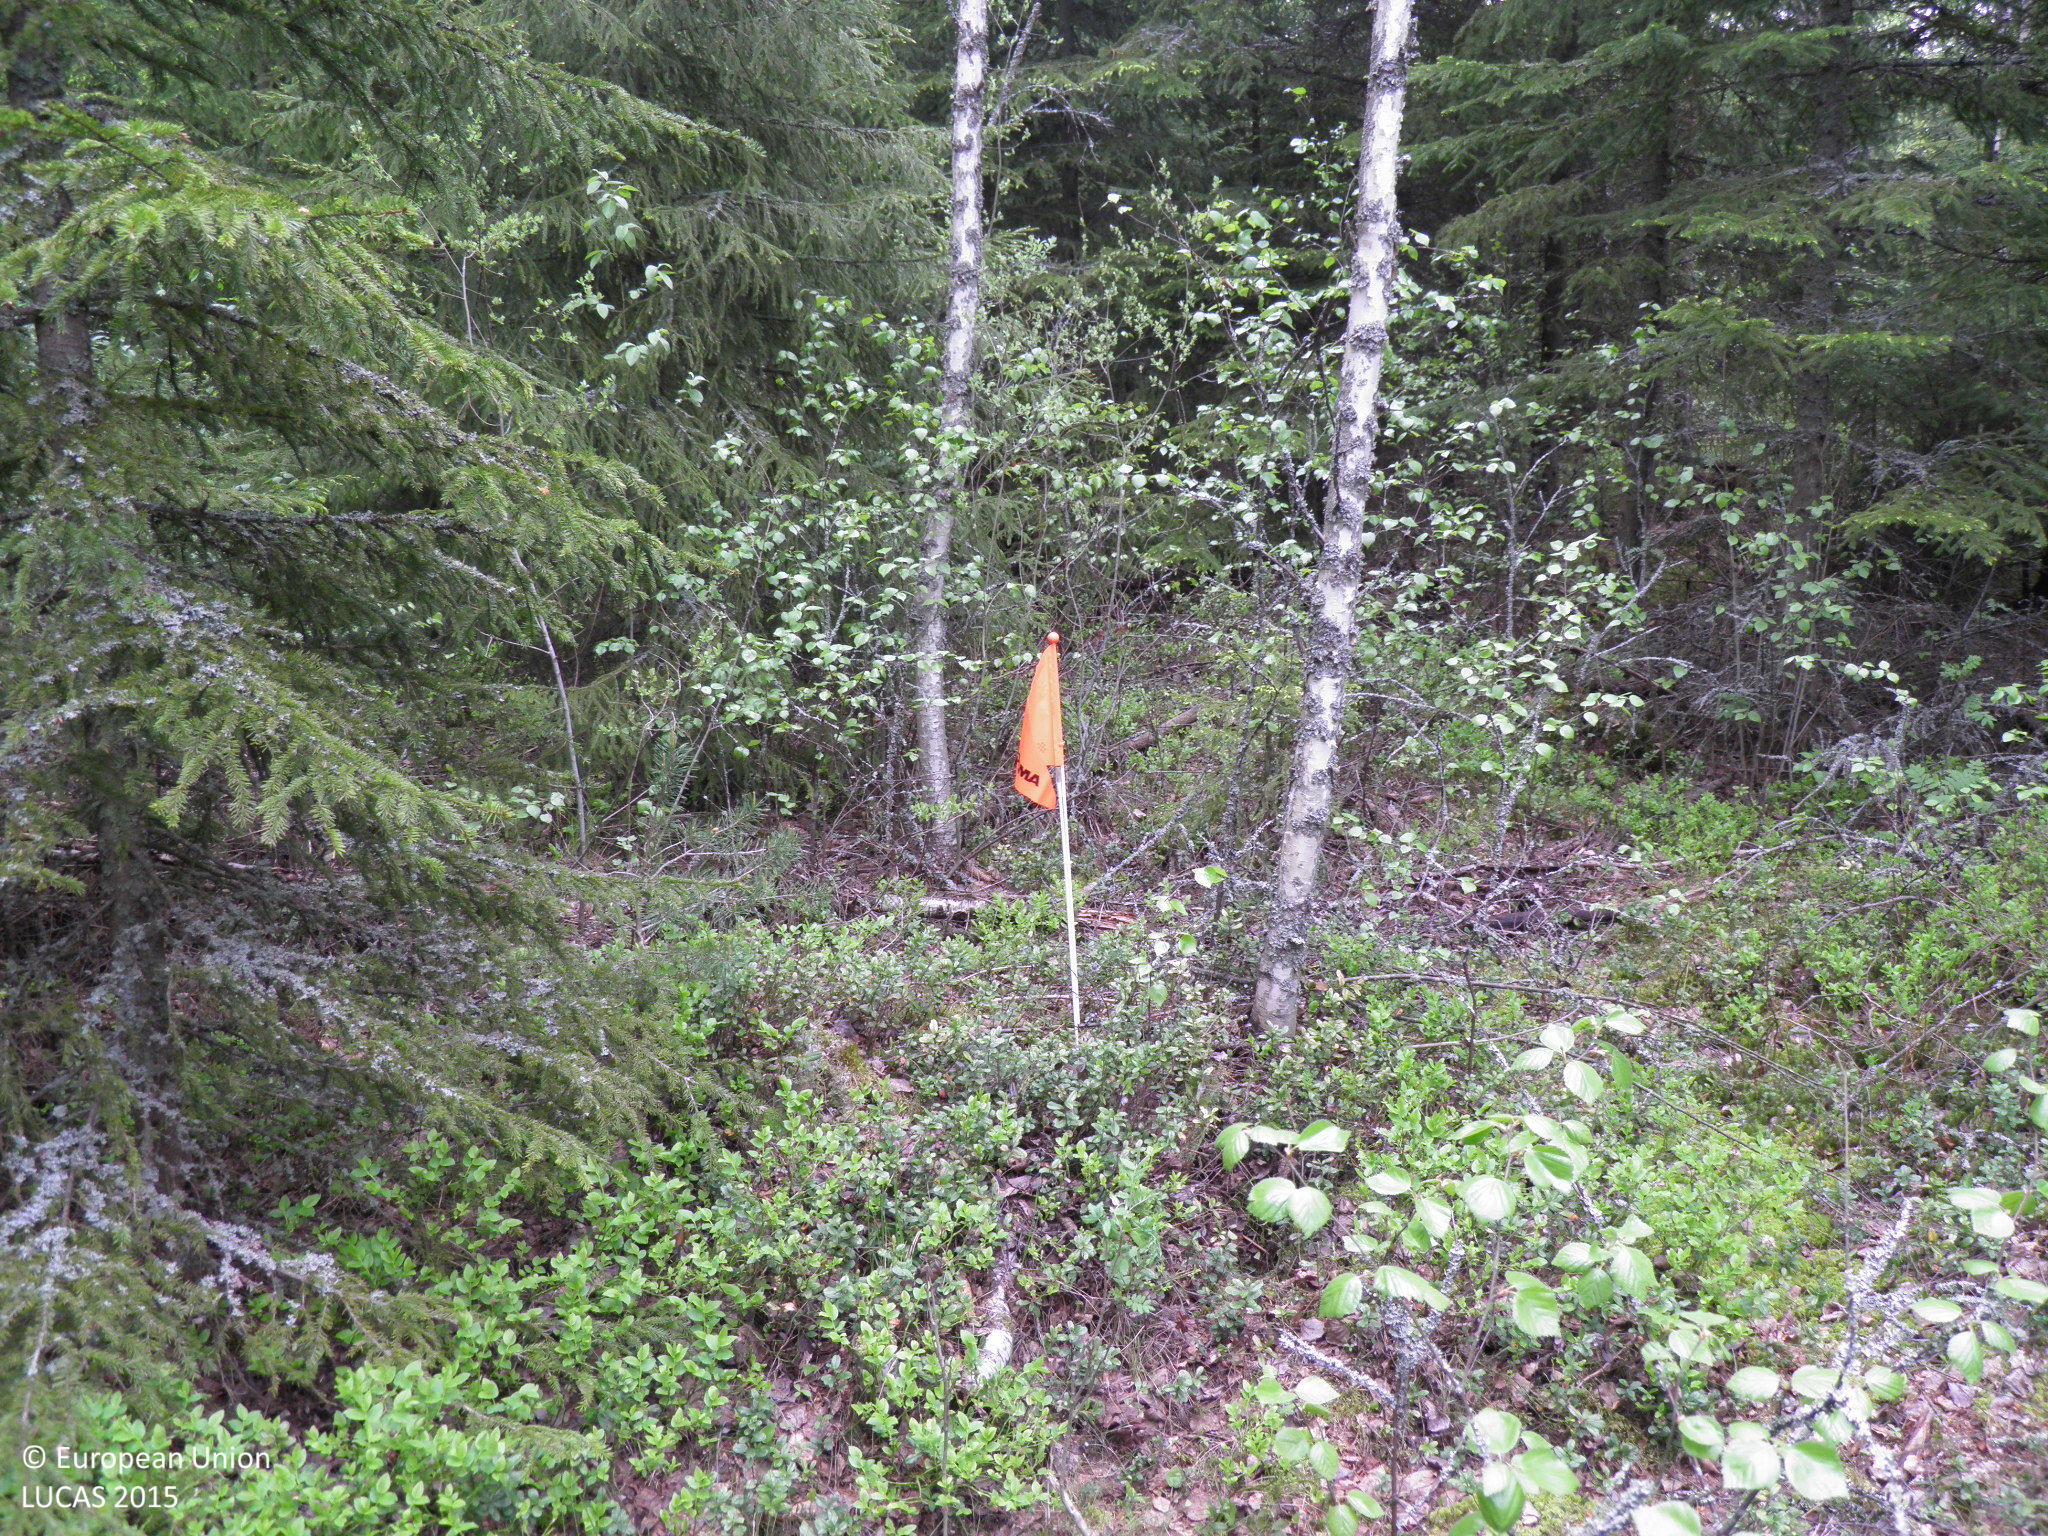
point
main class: Woodland
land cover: Spruce dominated coniferous woodland
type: boreal forest
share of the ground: > 75 %
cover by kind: coniferous forest trees 75 %, broadleaved forest trees 20 %, shrubs 5 %
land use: Forestry
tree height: > 5 m
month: June
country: FI
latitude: 60.5316
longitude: 22.3318
